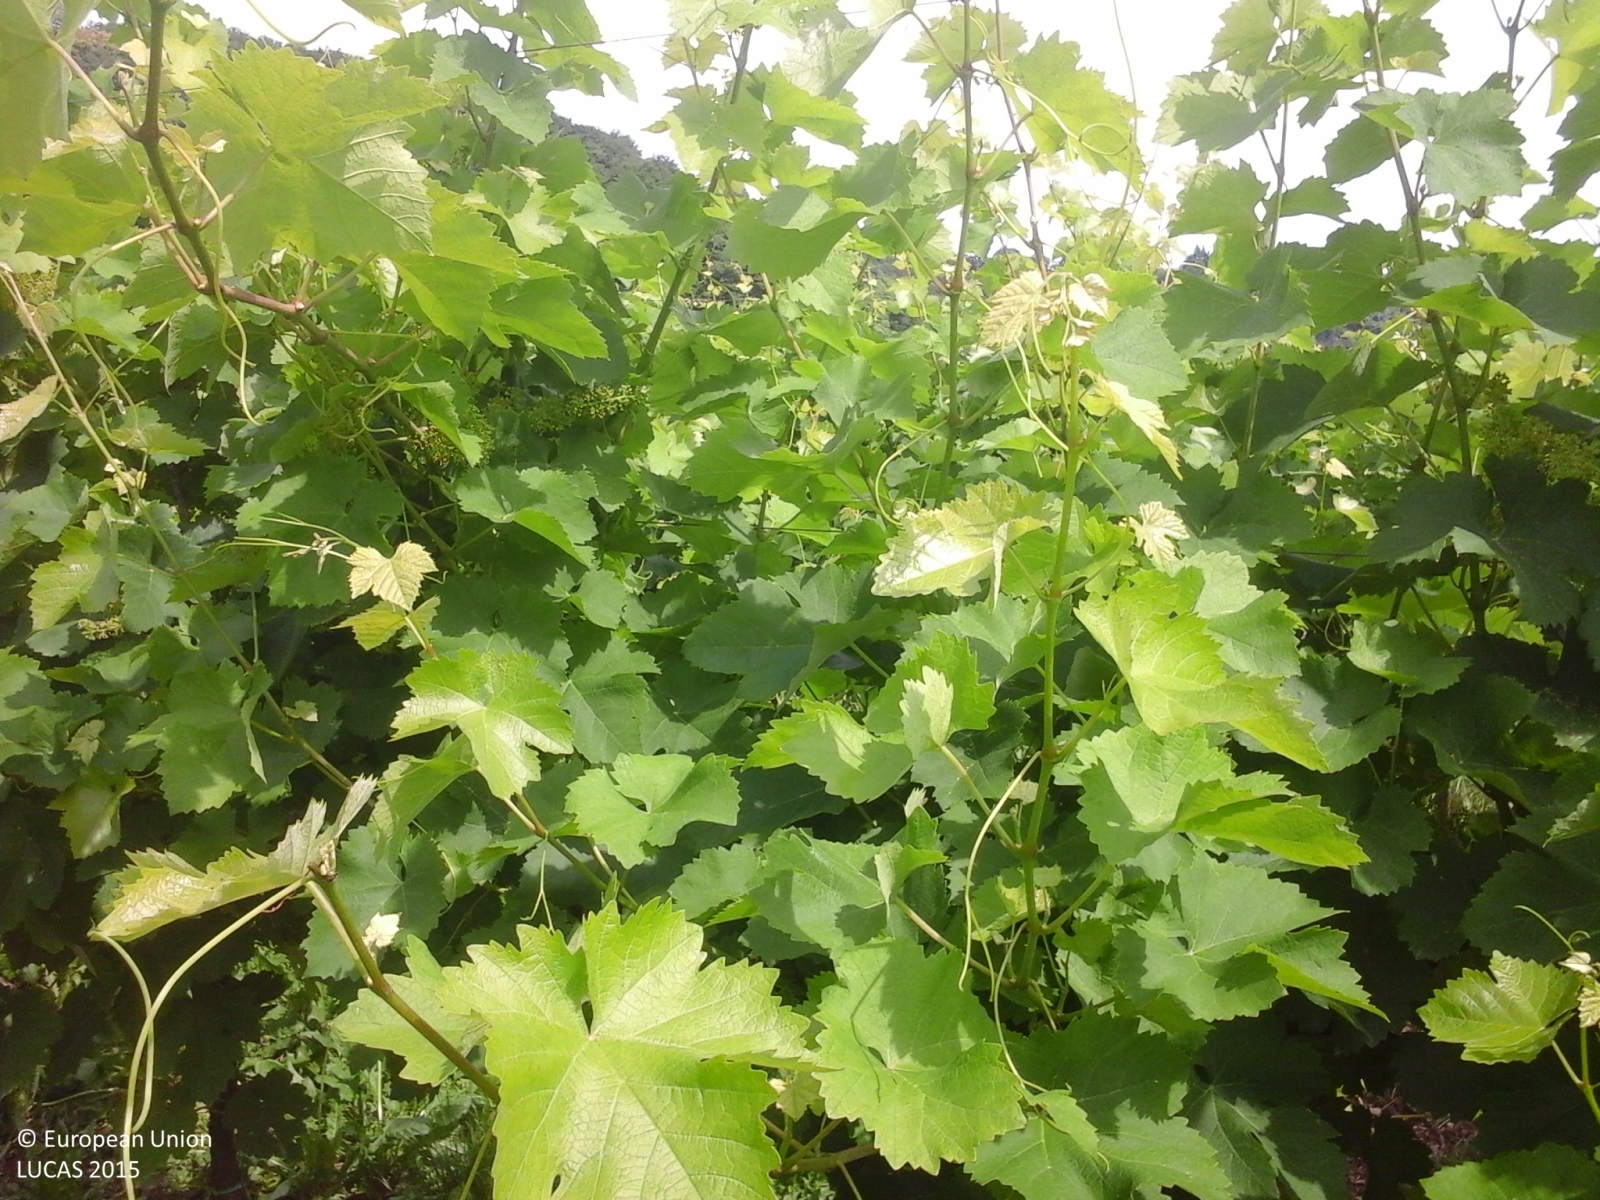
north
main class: Cropland
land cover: Vineyards
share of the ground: > 75 %
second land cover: Grassland without tree/shrub cover
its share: 50 - 75 %
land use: Agriculture (excluding fallow land and kitchen gardens)
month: May
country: IT
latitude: 45.4026
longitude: 11.5687
